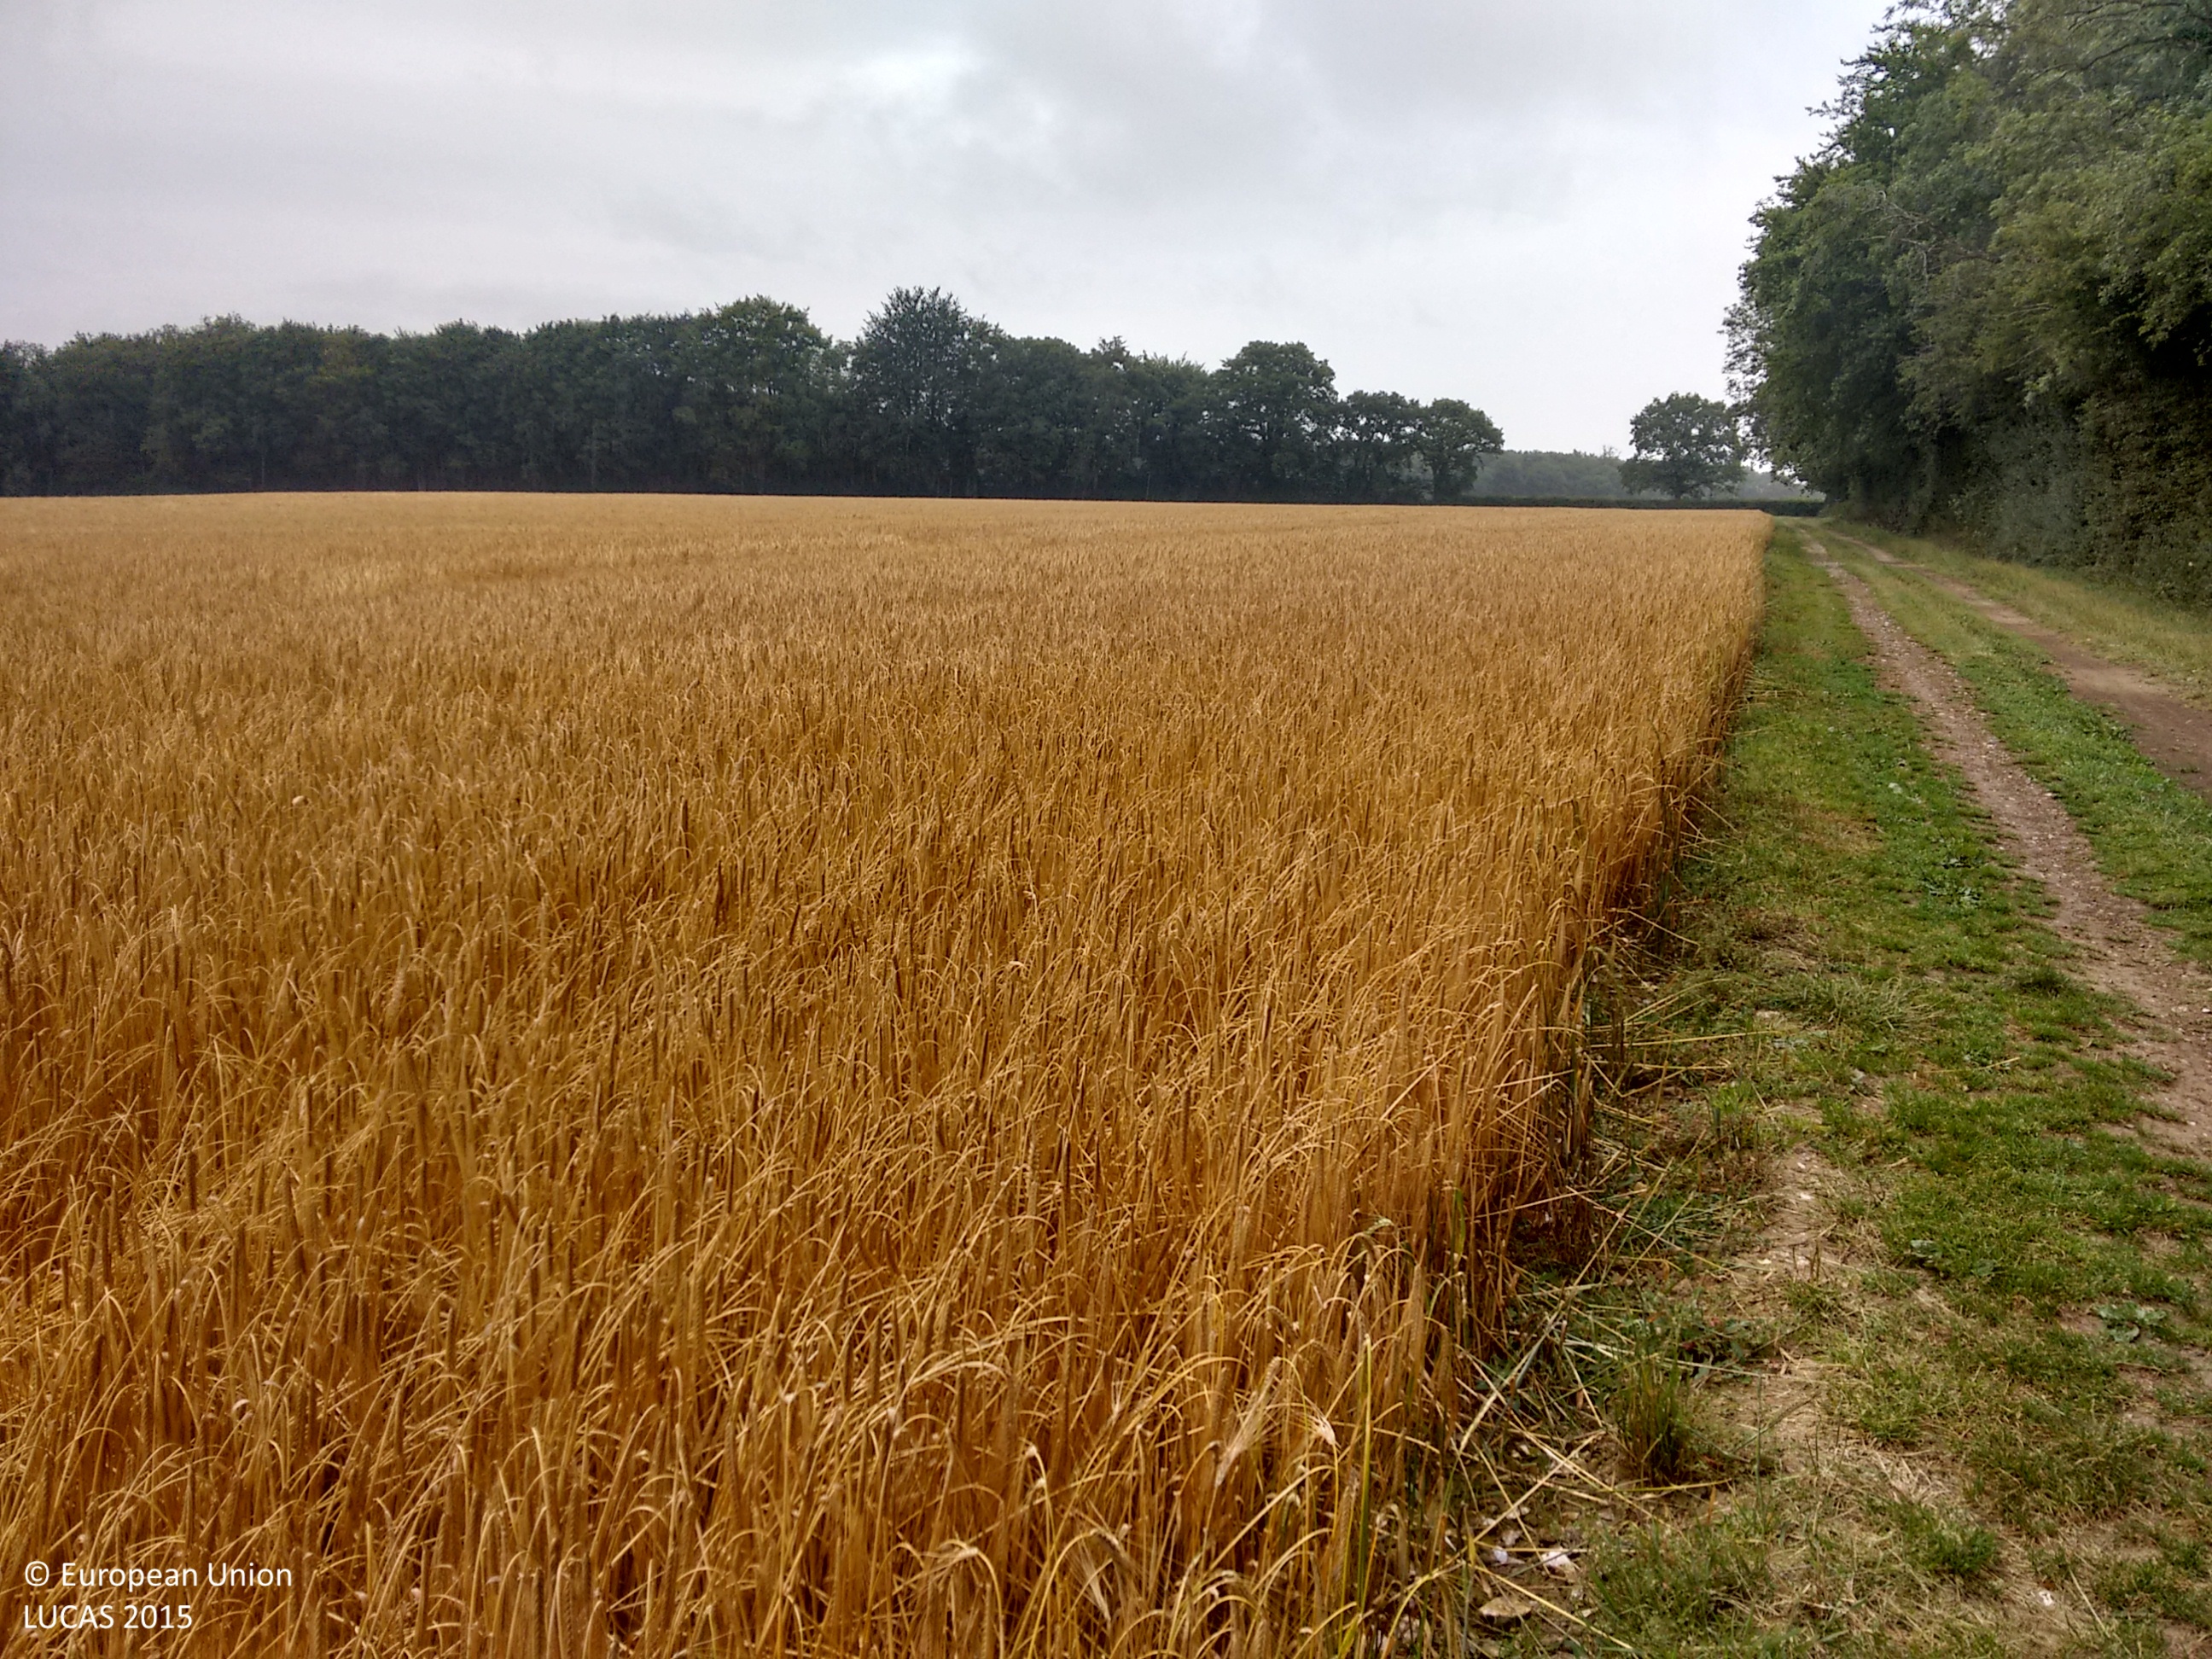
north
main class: Cropland
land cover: Barley
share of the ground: > 75 %
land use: Agriculture (excluding fallow land and kitchen gardens)
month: July
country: GB
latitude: 51.0207
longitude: -1.0940
